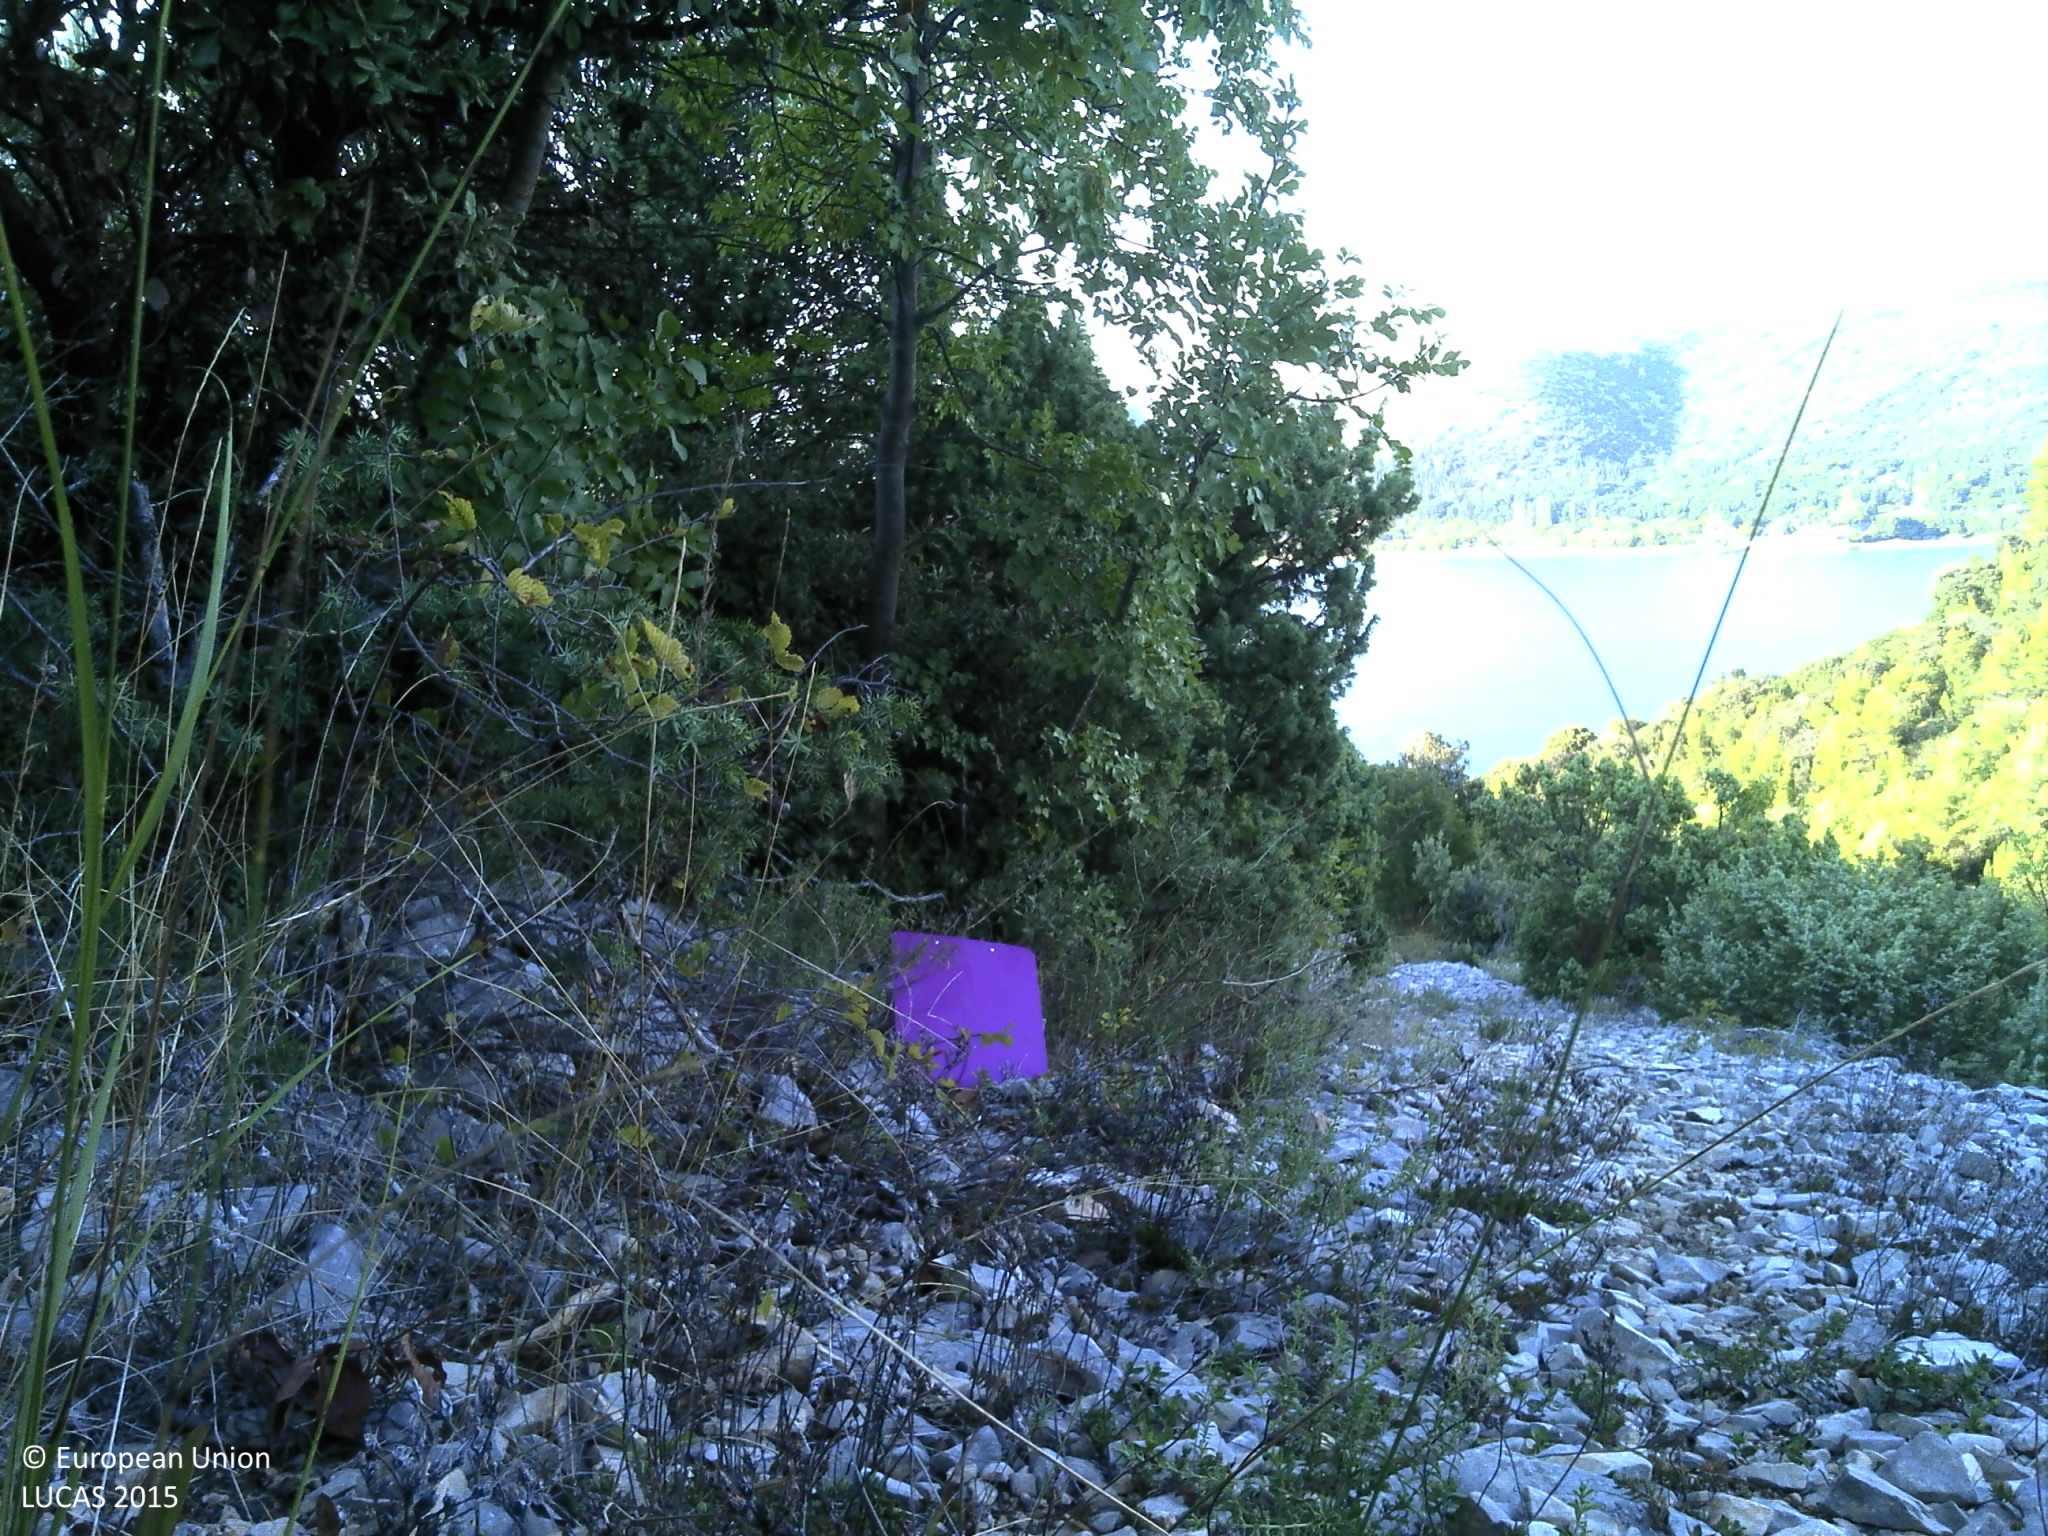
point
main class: Woodland
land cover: Broadleaved woodland
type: thermophilous deciduous forest
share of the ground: 25 - 50 %
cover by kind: broadleaved forest trees 40 %, shrubs 25 %, consolidated bare surface 25 %, coniferous forest trees 5 %, unconsolidated bare surface 5 %
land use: Semi-natural and natural areas not in use
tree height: > 5 m
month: September
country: HR
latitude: 43.8528
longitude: 15.9753
